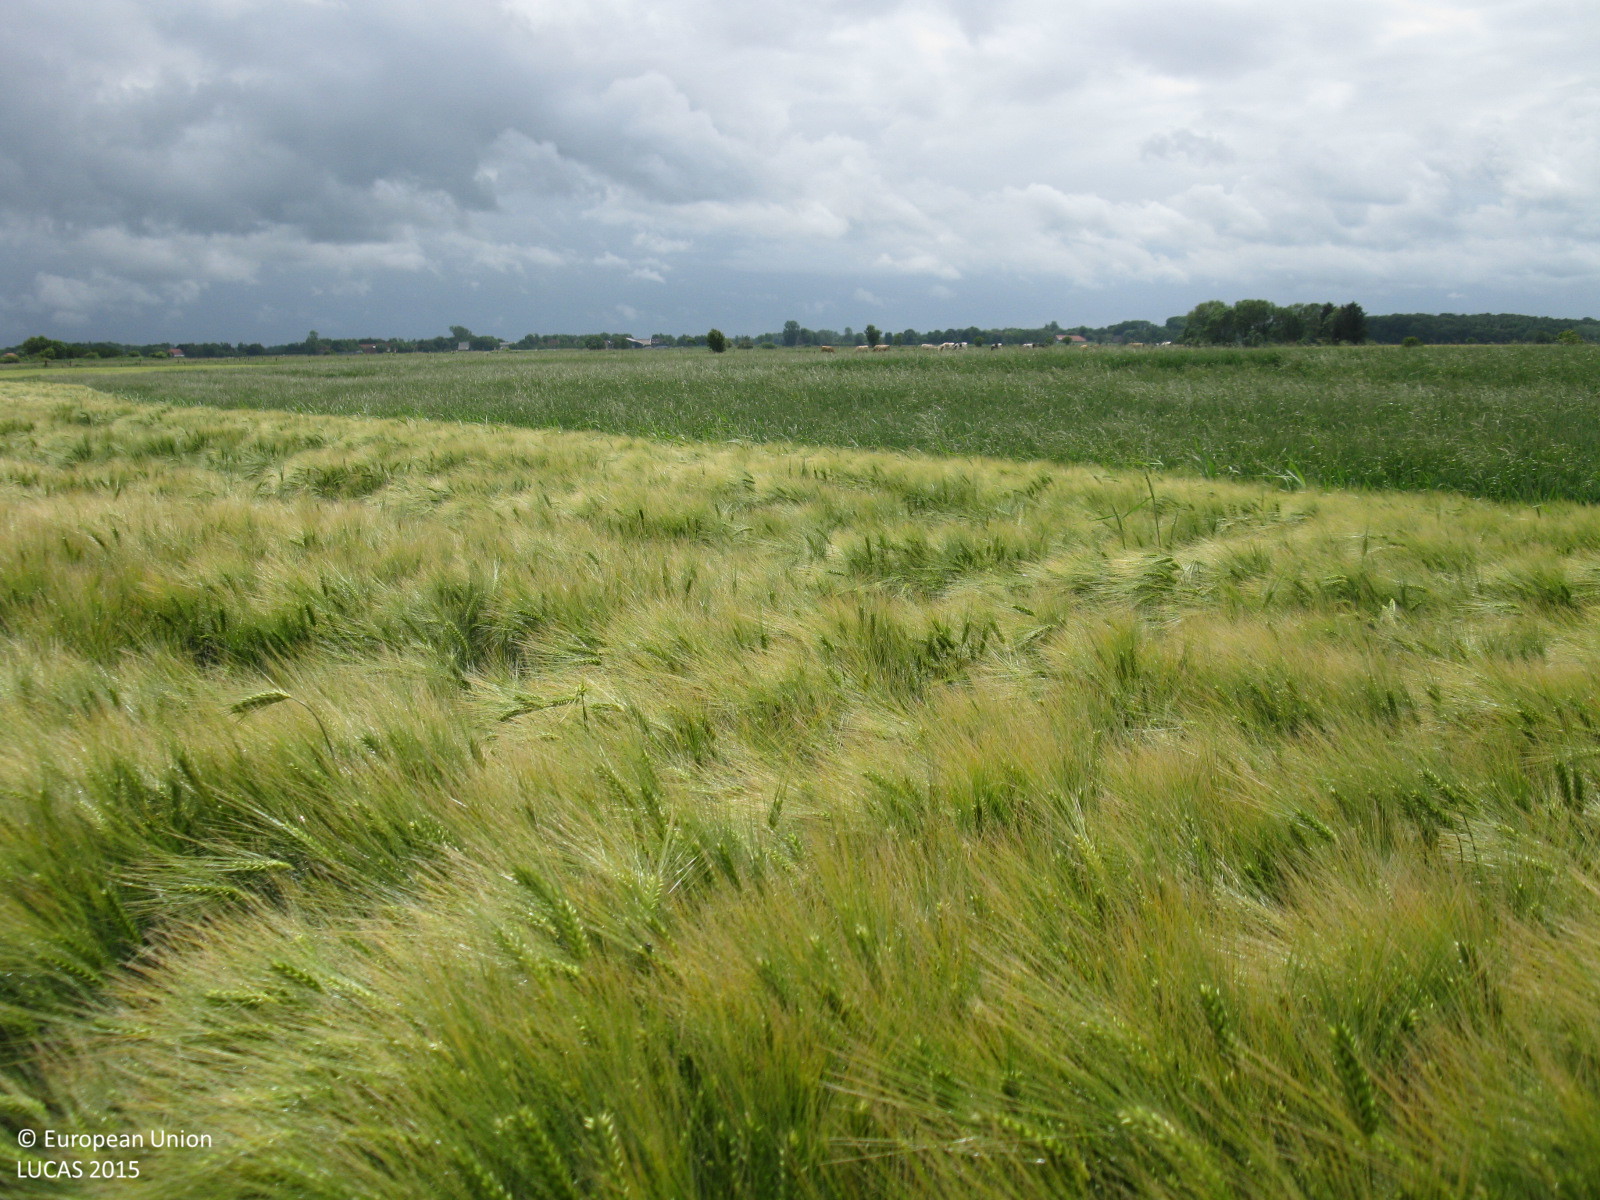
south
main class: Cropland
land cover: Common wheat
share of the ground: > 75 %
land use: Agriculture (excluding fallow land and kitchen gardens)
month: June
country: DE
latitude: 53.6242
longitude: 7.3245
